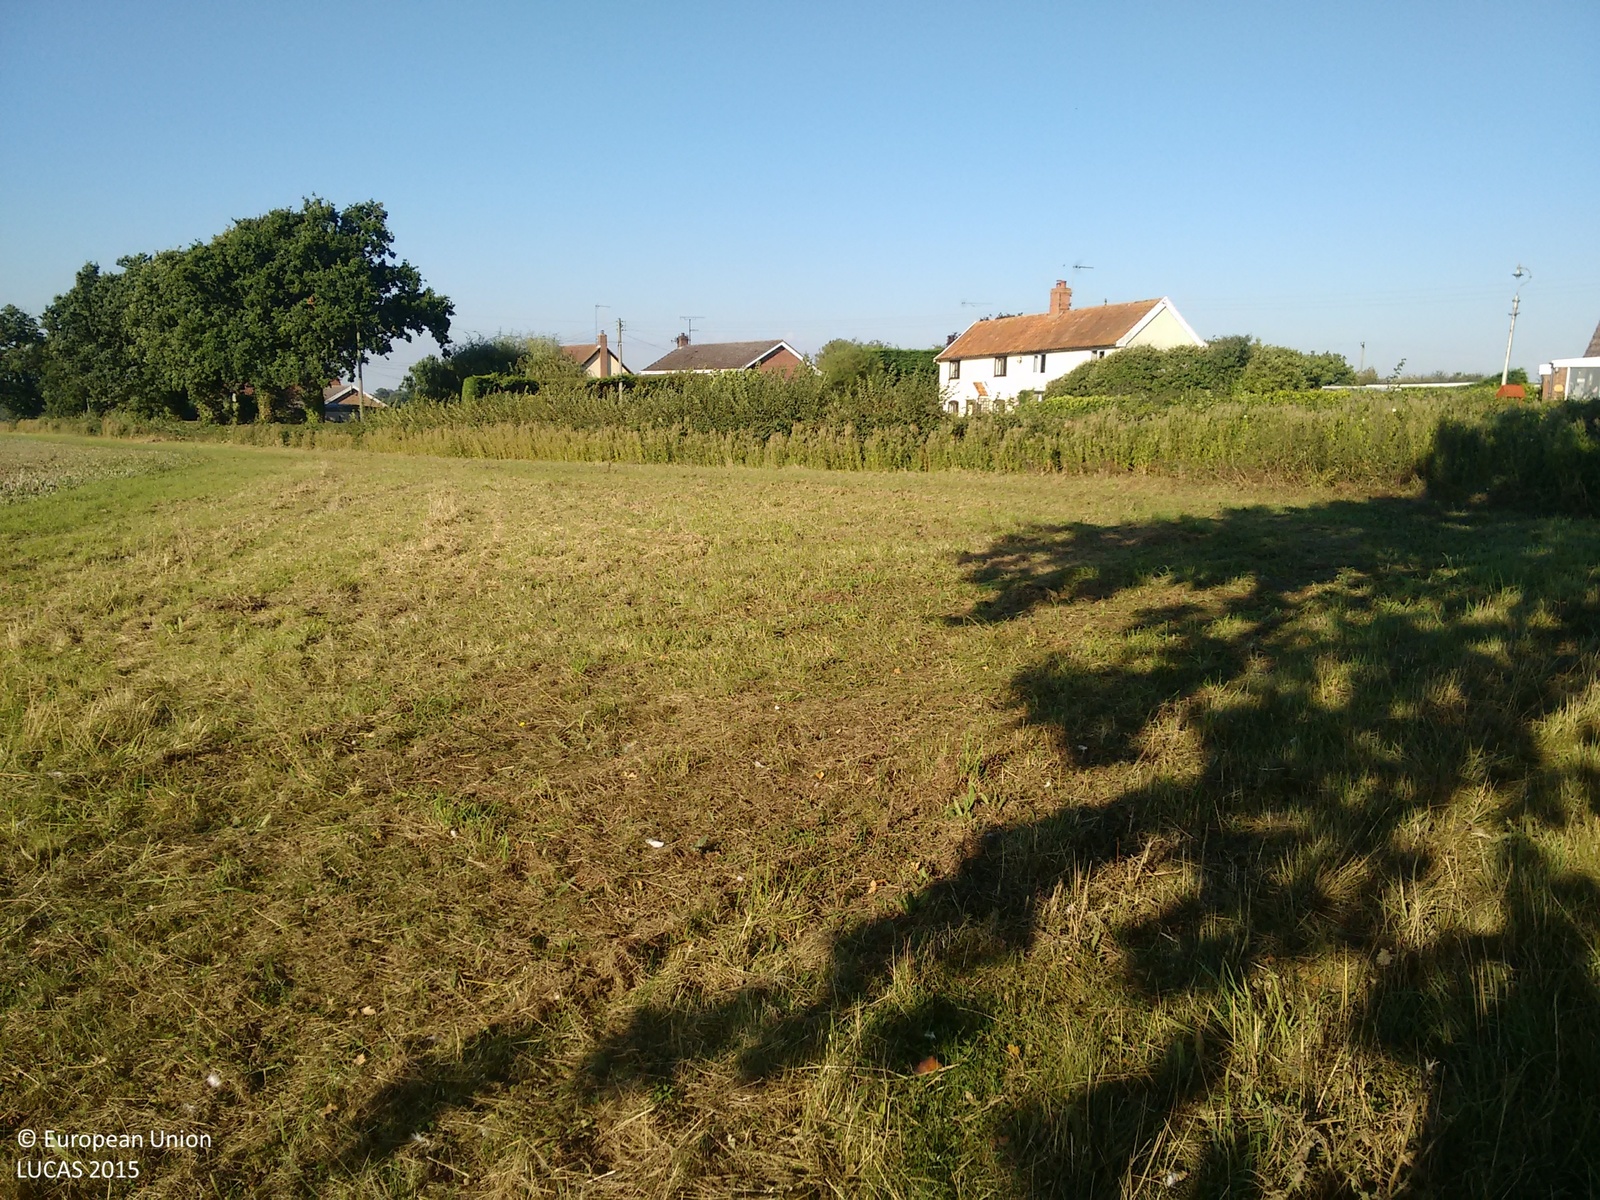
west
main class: Grassland
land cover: Grassland without tree/shrub cover
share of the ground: > 75 %
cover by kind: herbaceous plants 80 %, unconsolidated bare surface 20 %
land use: Agriculture (excluding fallow land and kitchen gardens)
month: September
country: GB
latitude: 52.2467
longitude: 1.4119
